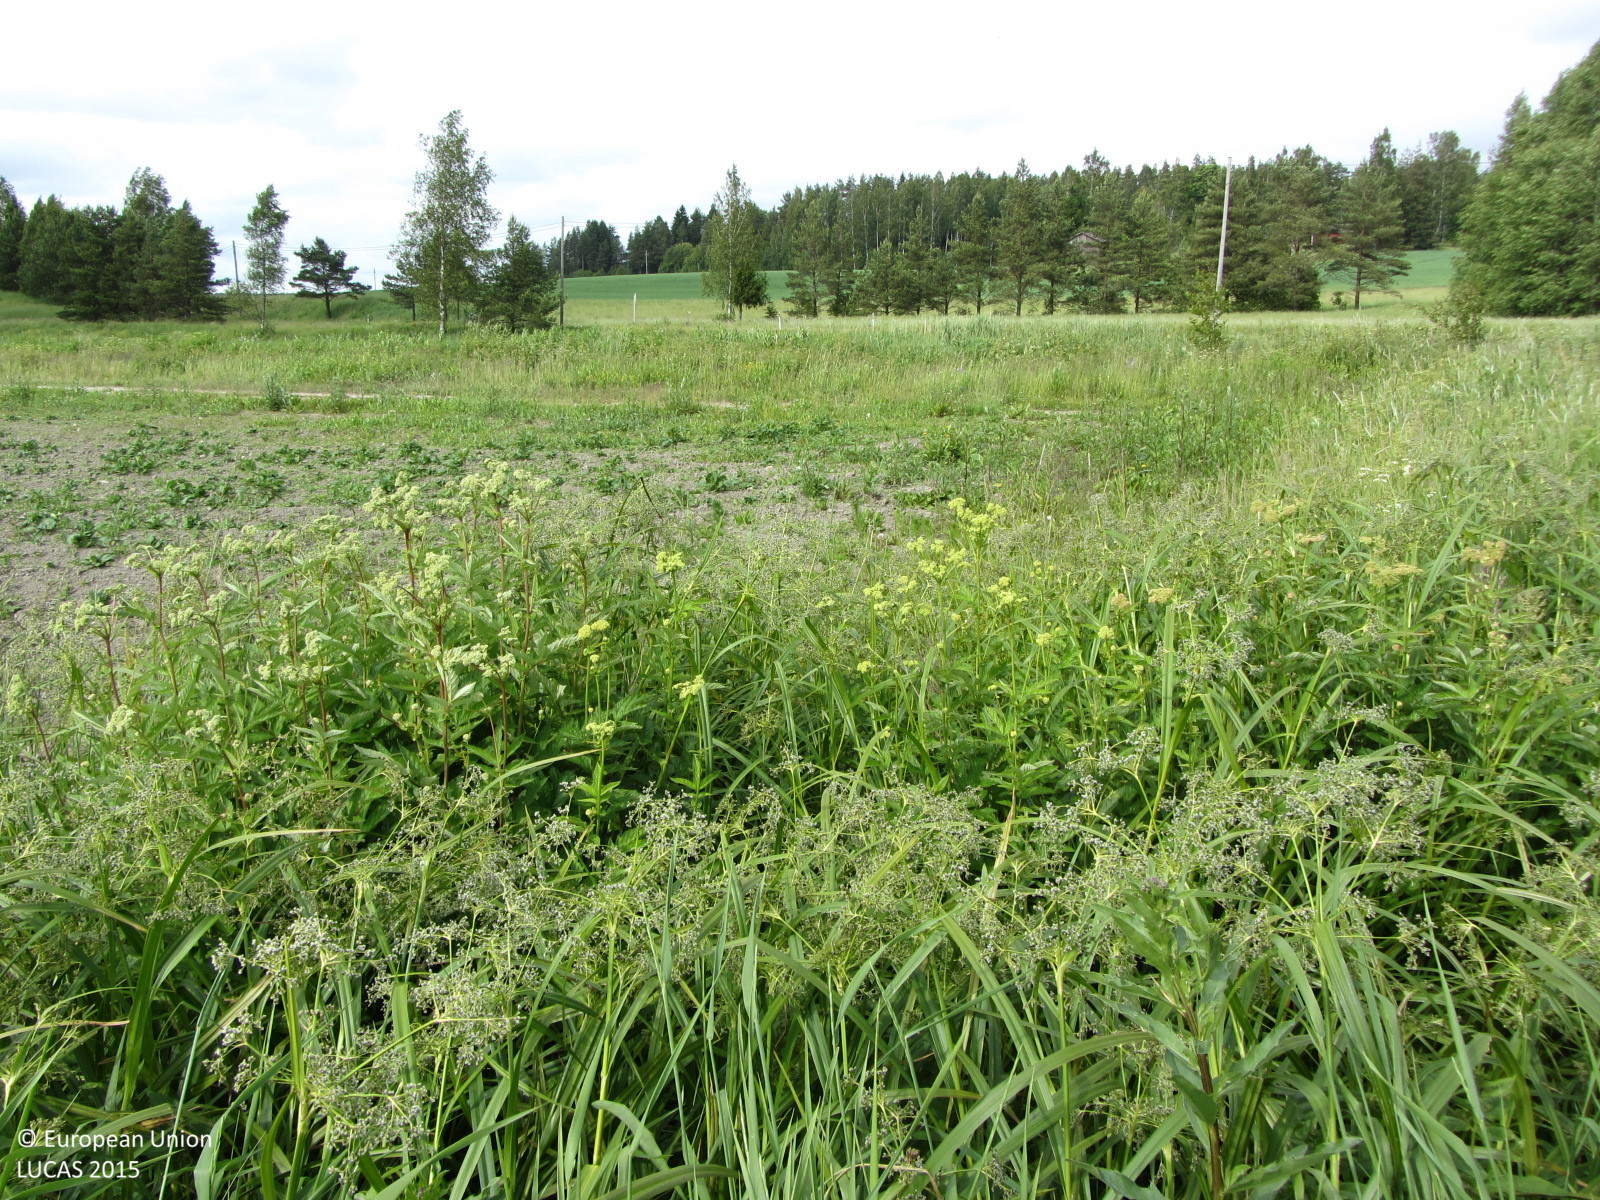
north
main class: Cropland
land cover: Common wheat
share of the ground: > 75 %
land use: Agriculture (excluding fallow land and kitchen gardens)
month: June
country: FI
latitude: 60.0847
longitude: 23.2252
